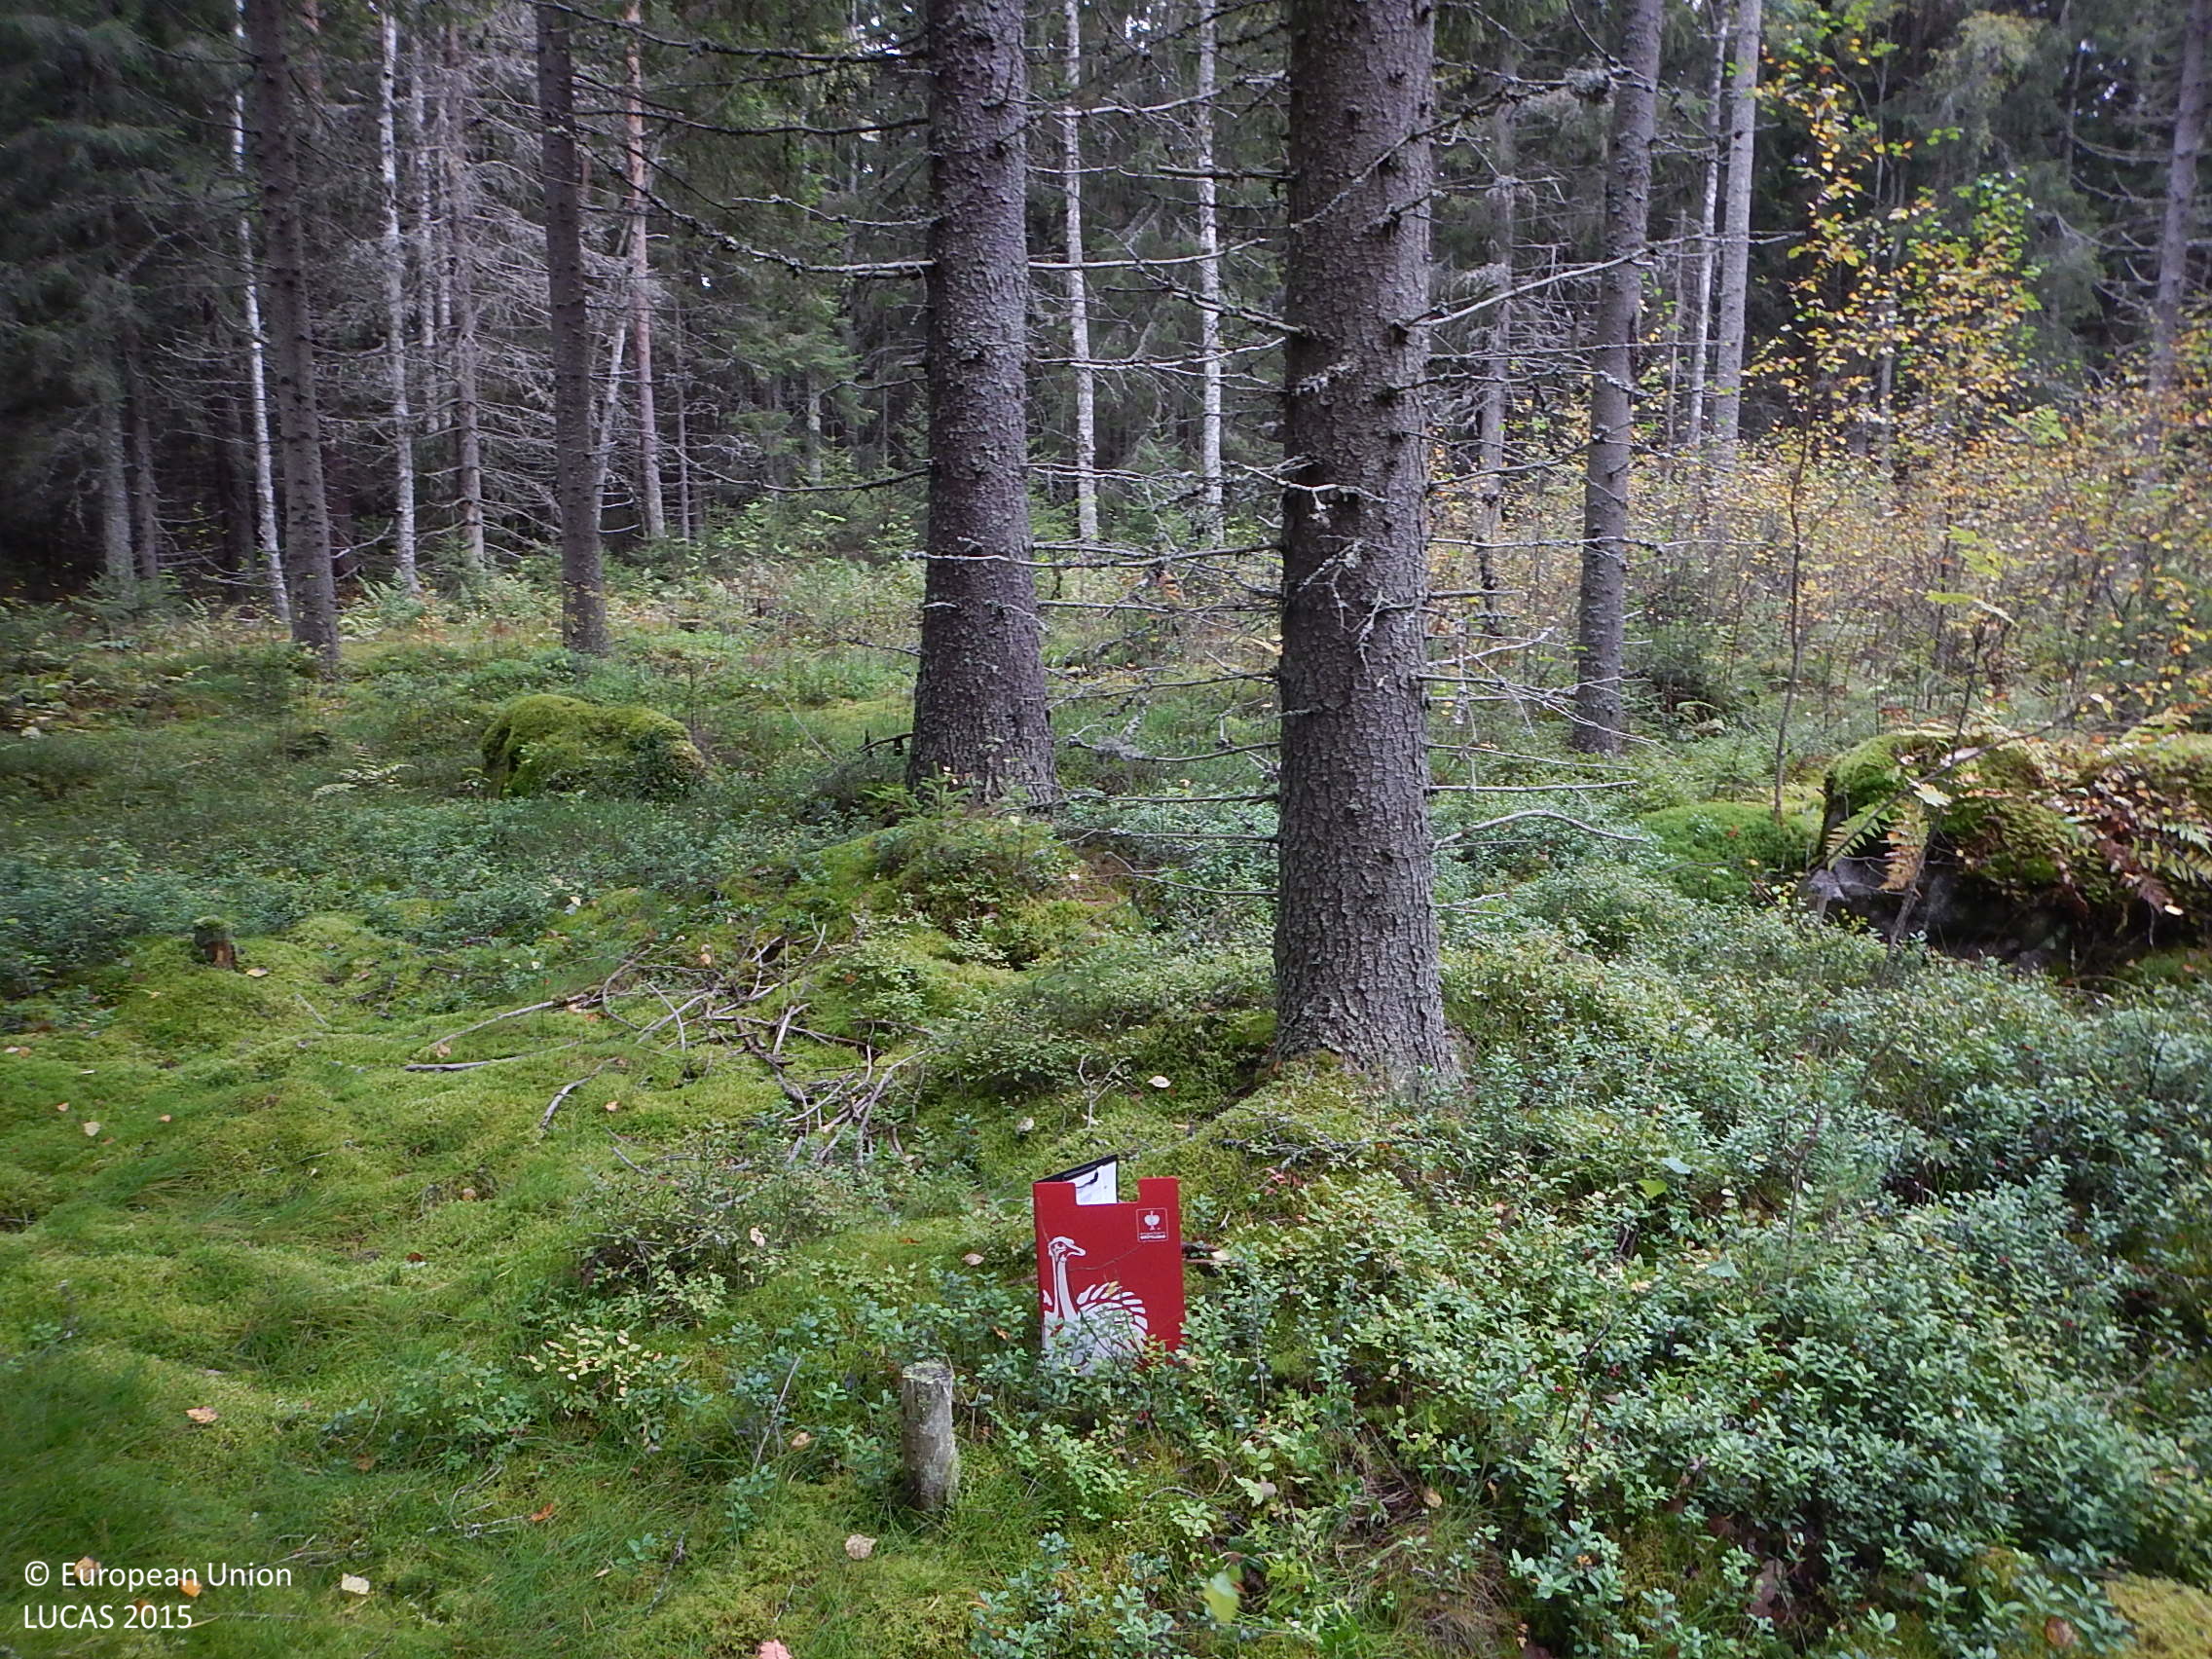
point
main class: Woodland
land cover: Spruce dominated coniferous woodland
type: boreal forest
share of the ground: > 75 %
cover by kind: coniferous forest trees 80 %, shrubs 10 %, lichens and mosses 10 %
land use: Forestry
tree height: > 5 m
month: September
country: FI
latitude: 61.9630
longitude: 22.9004
